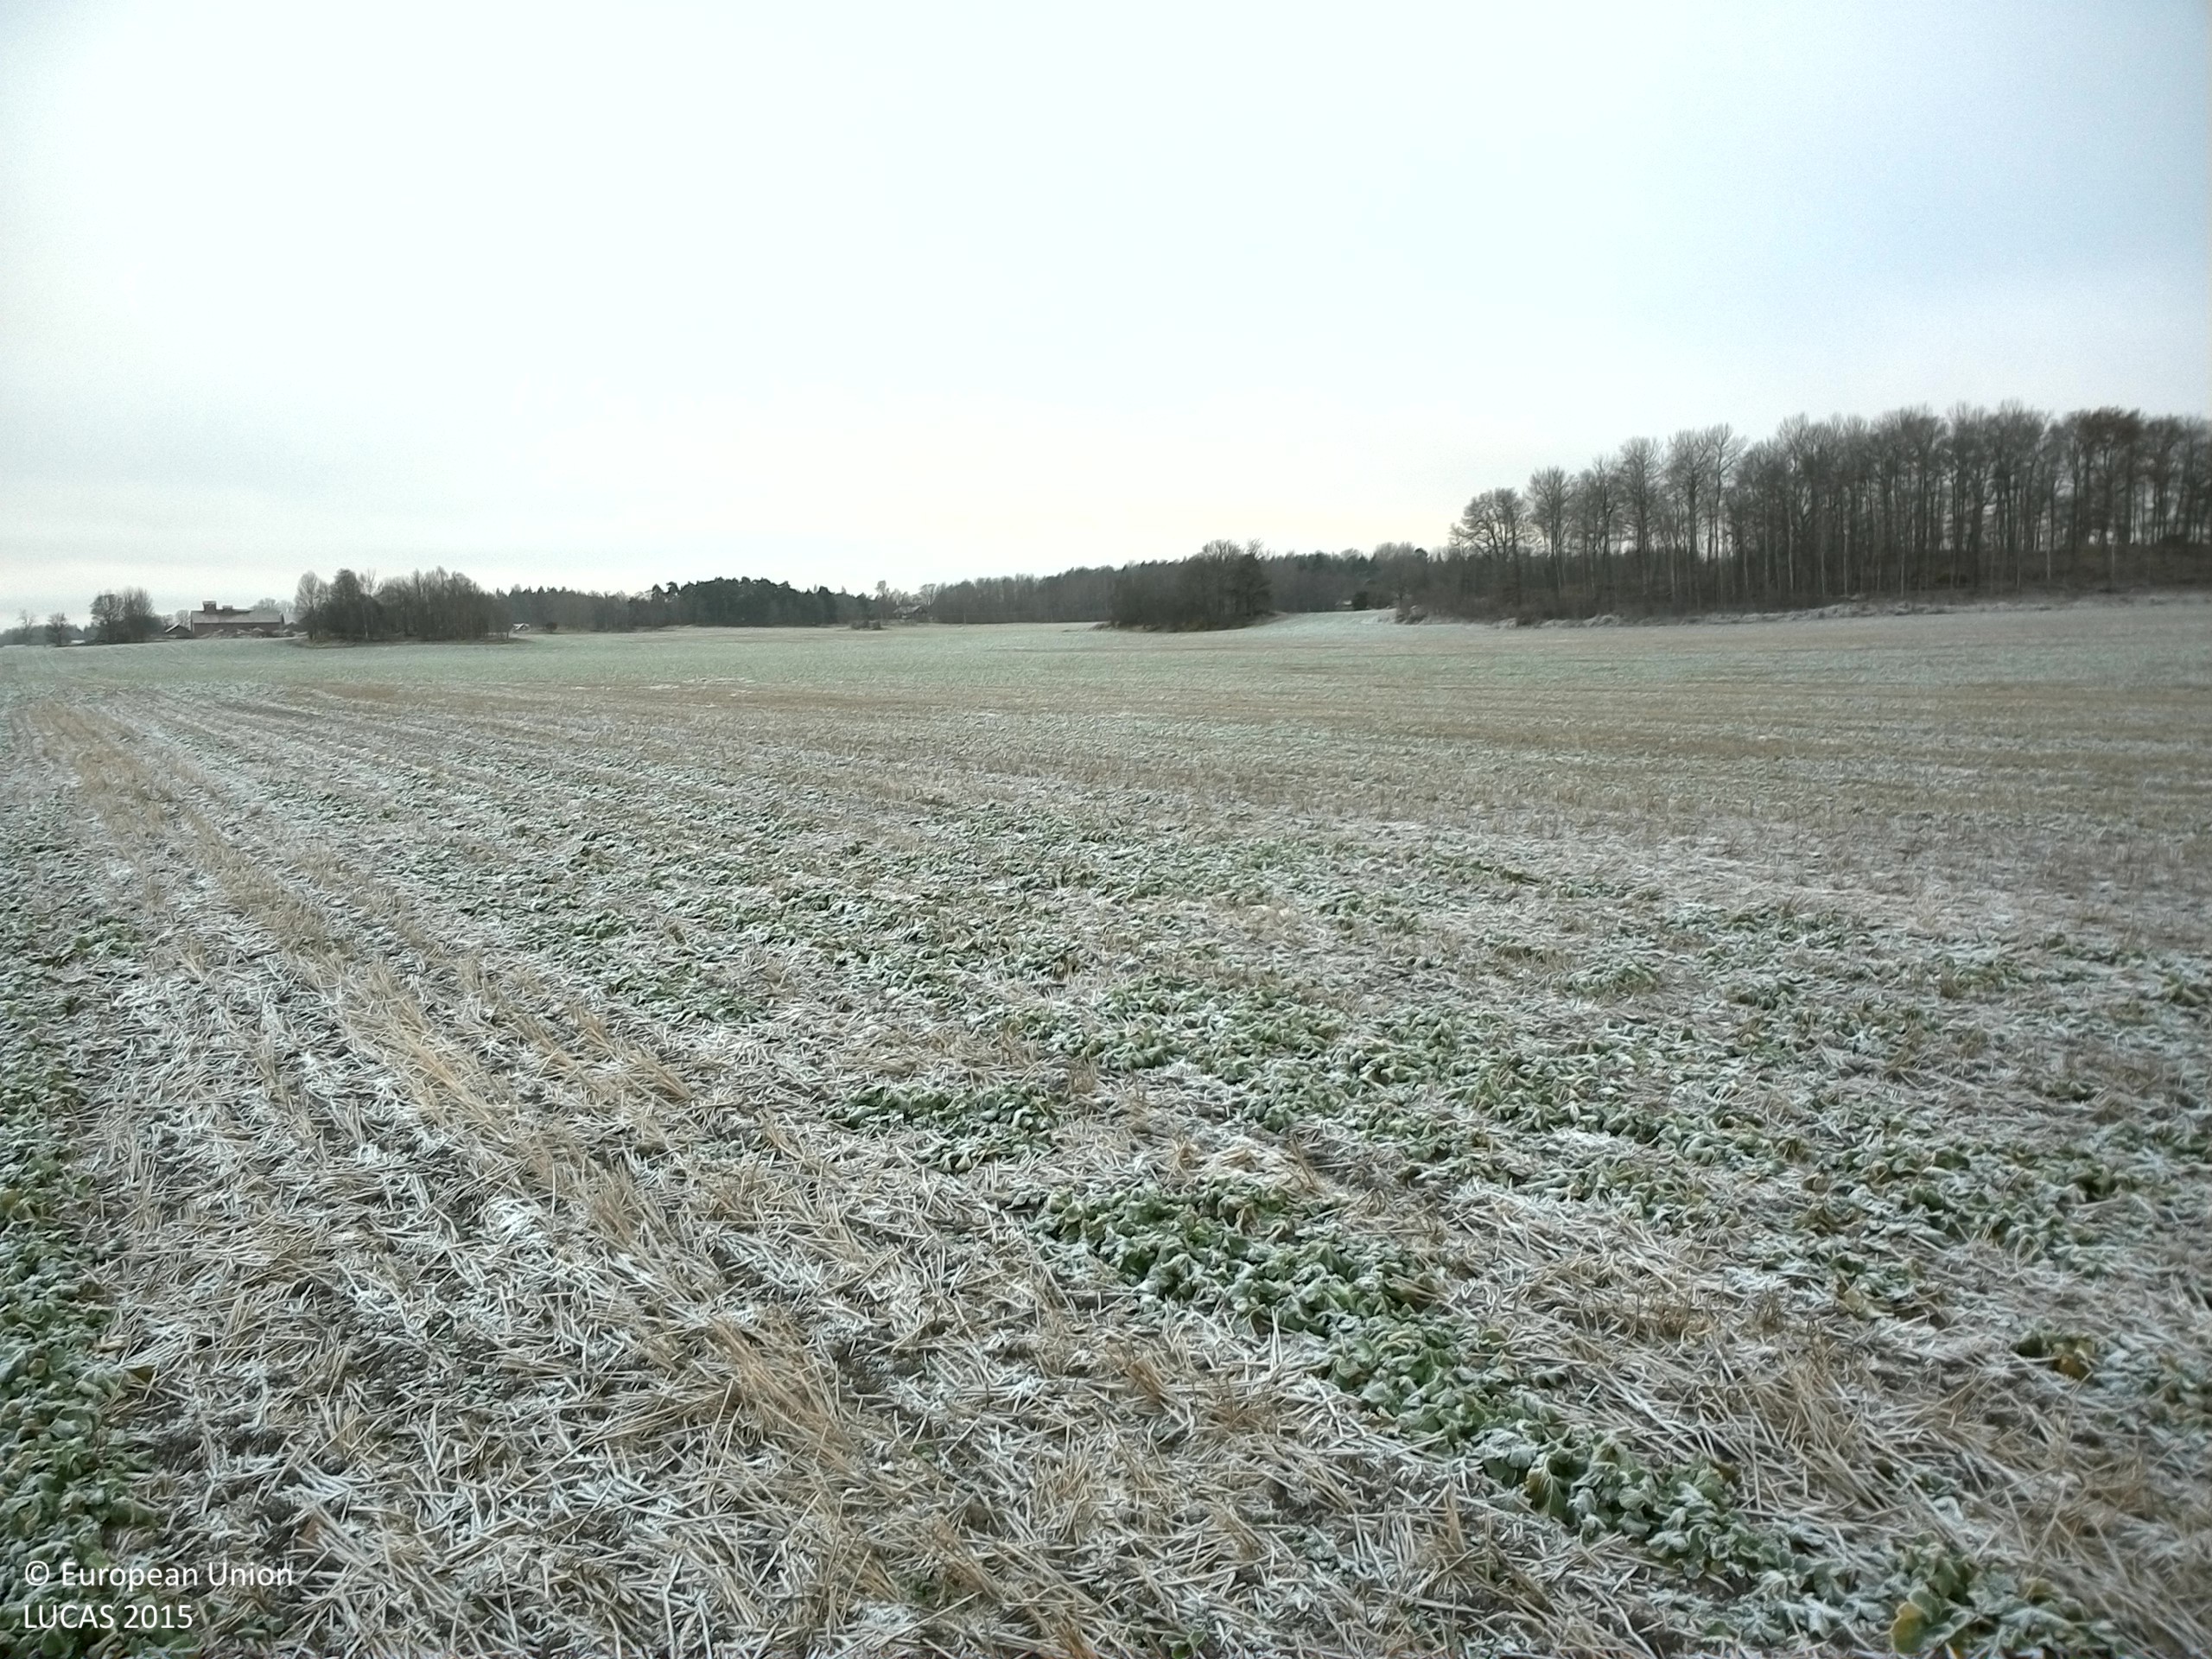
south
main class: Cropland
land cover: Other leguminous and mixtures for fodder
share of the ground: 50 - 75 %
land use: Agriculture (excluding fallow land and kitchen gardens)
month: December
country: SE
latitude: 59.4019
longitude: 17.1633
